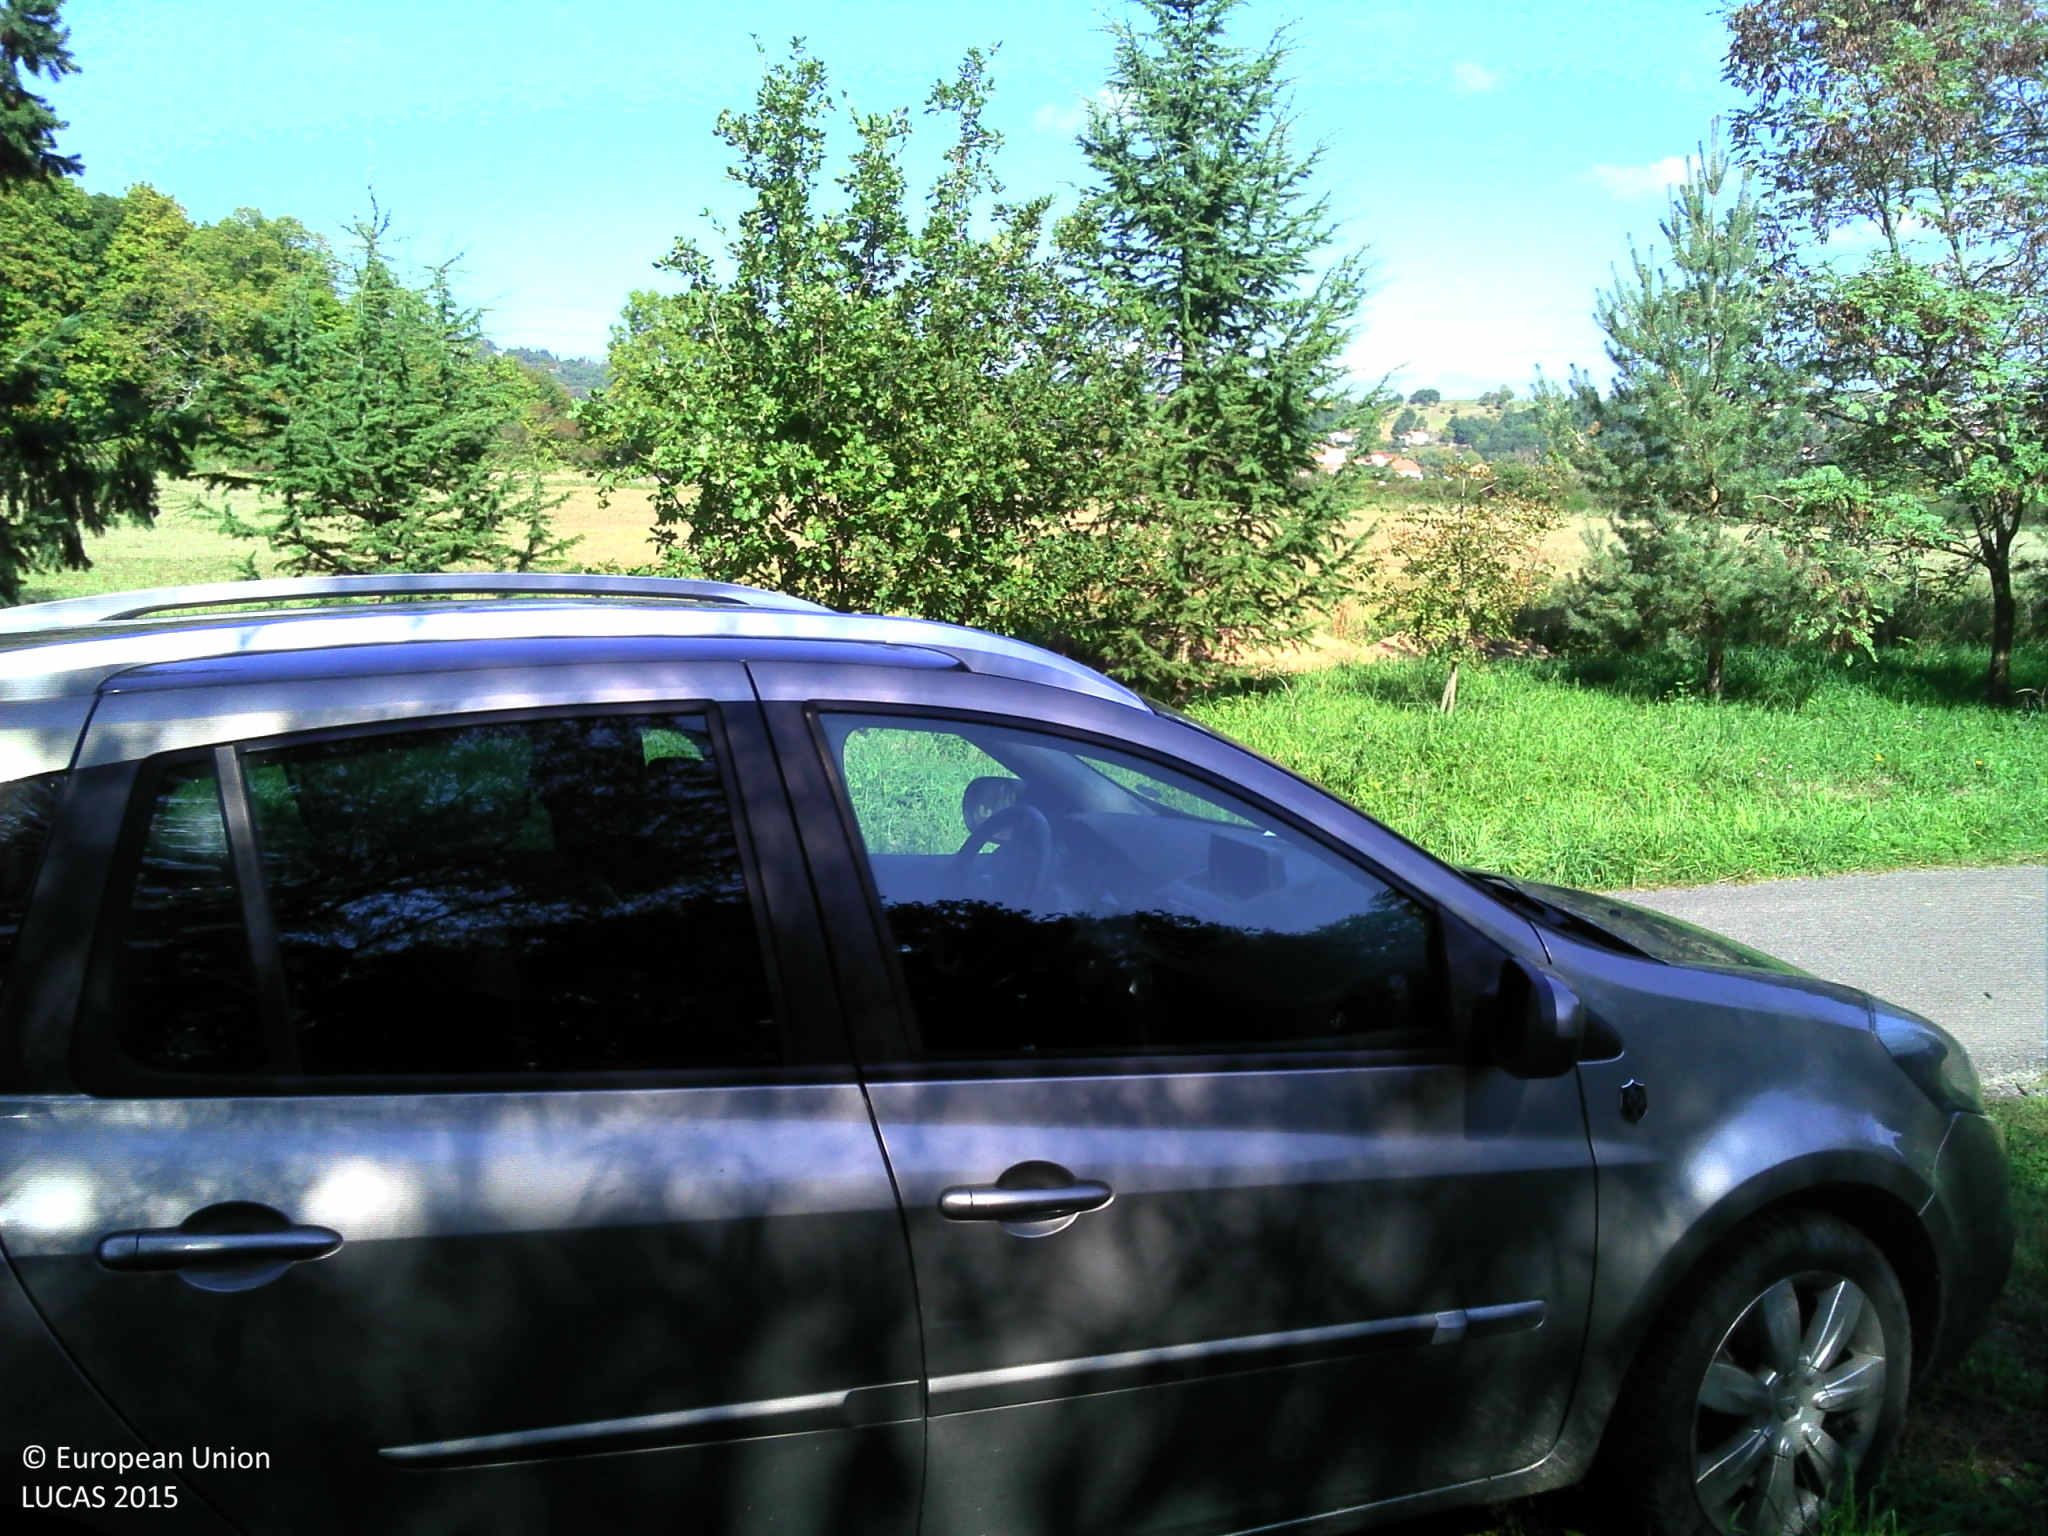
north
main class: Grassland
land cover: Grassland without tree/shrub cover
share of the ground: > 75 %
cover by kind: herbaceous plants 100 %
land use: Agriculture (excluding fallow land and kitchen gardens)
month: October
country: FR
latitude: 45.8902
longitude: 3.0531
